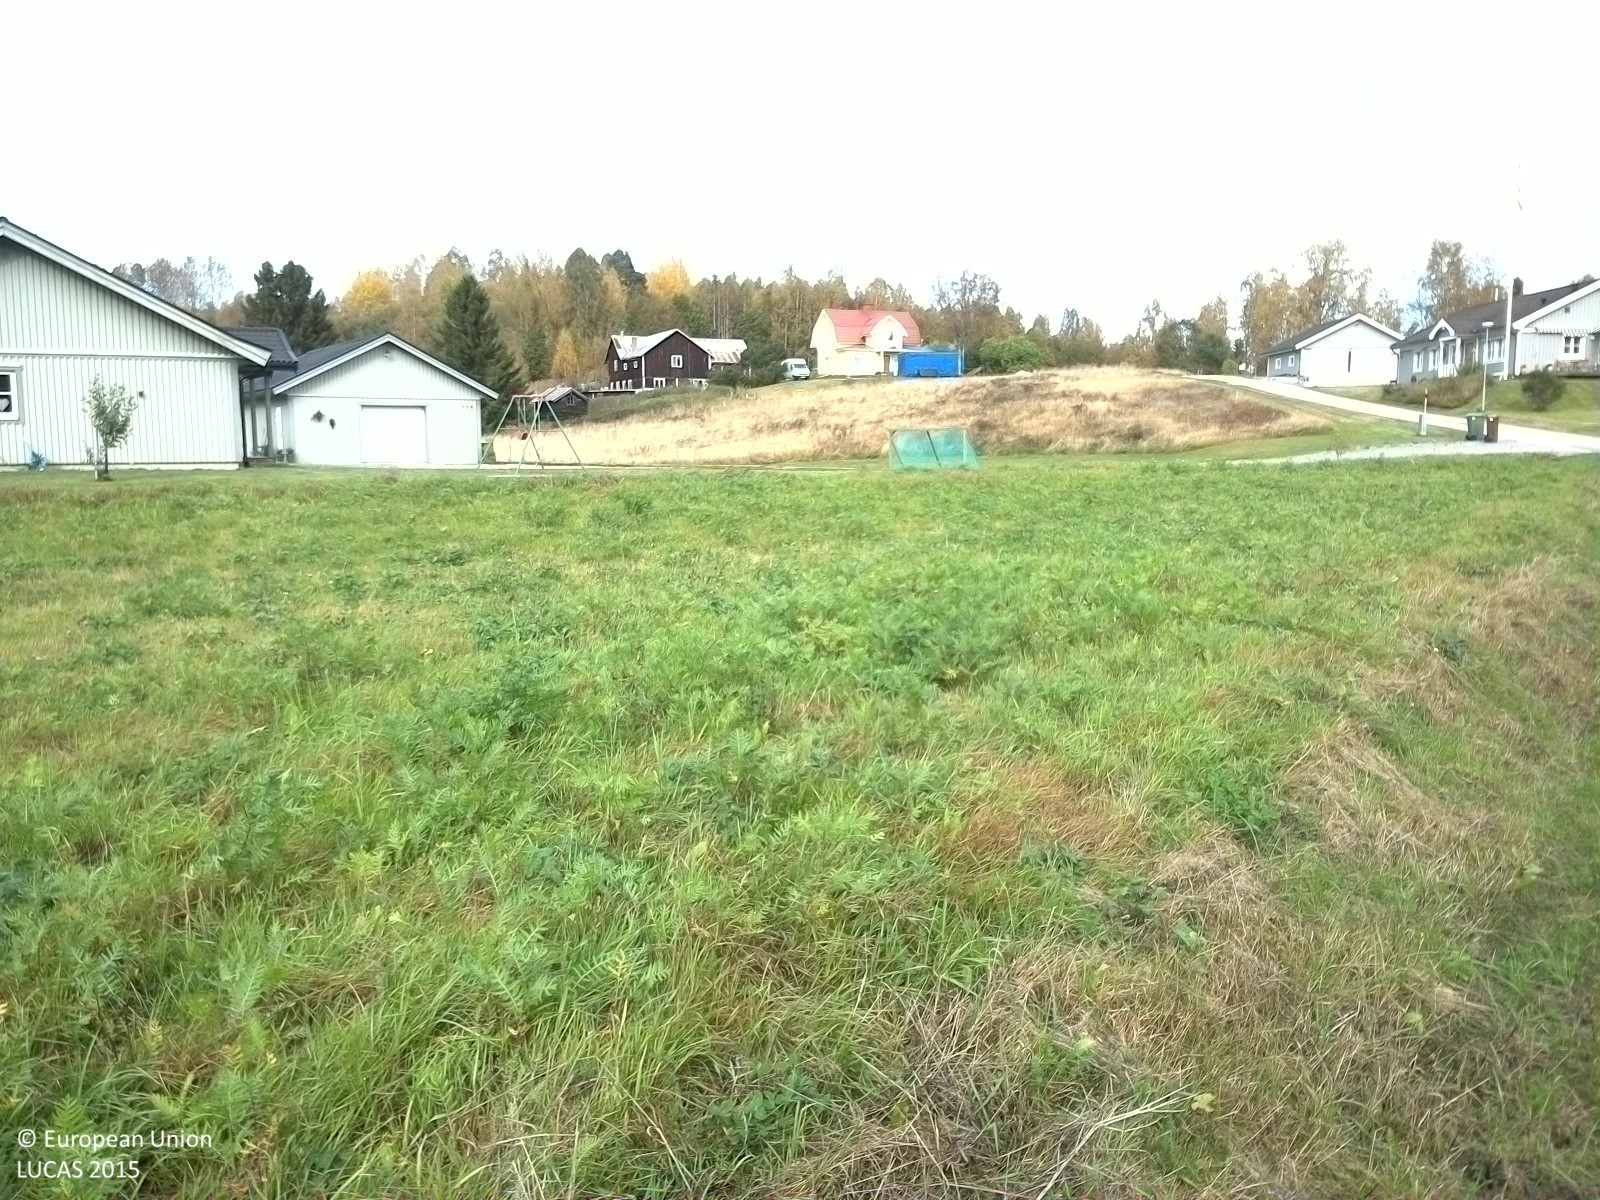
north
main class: Grassland
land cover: Grassland without tree/shrub cover
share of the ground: > 75 %
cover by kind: herbaceous plants 100 %
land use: Agriculture (excluding fallow land and kitchen gardens)
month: September
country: SE
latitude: 62.3144
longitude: 17.1769
